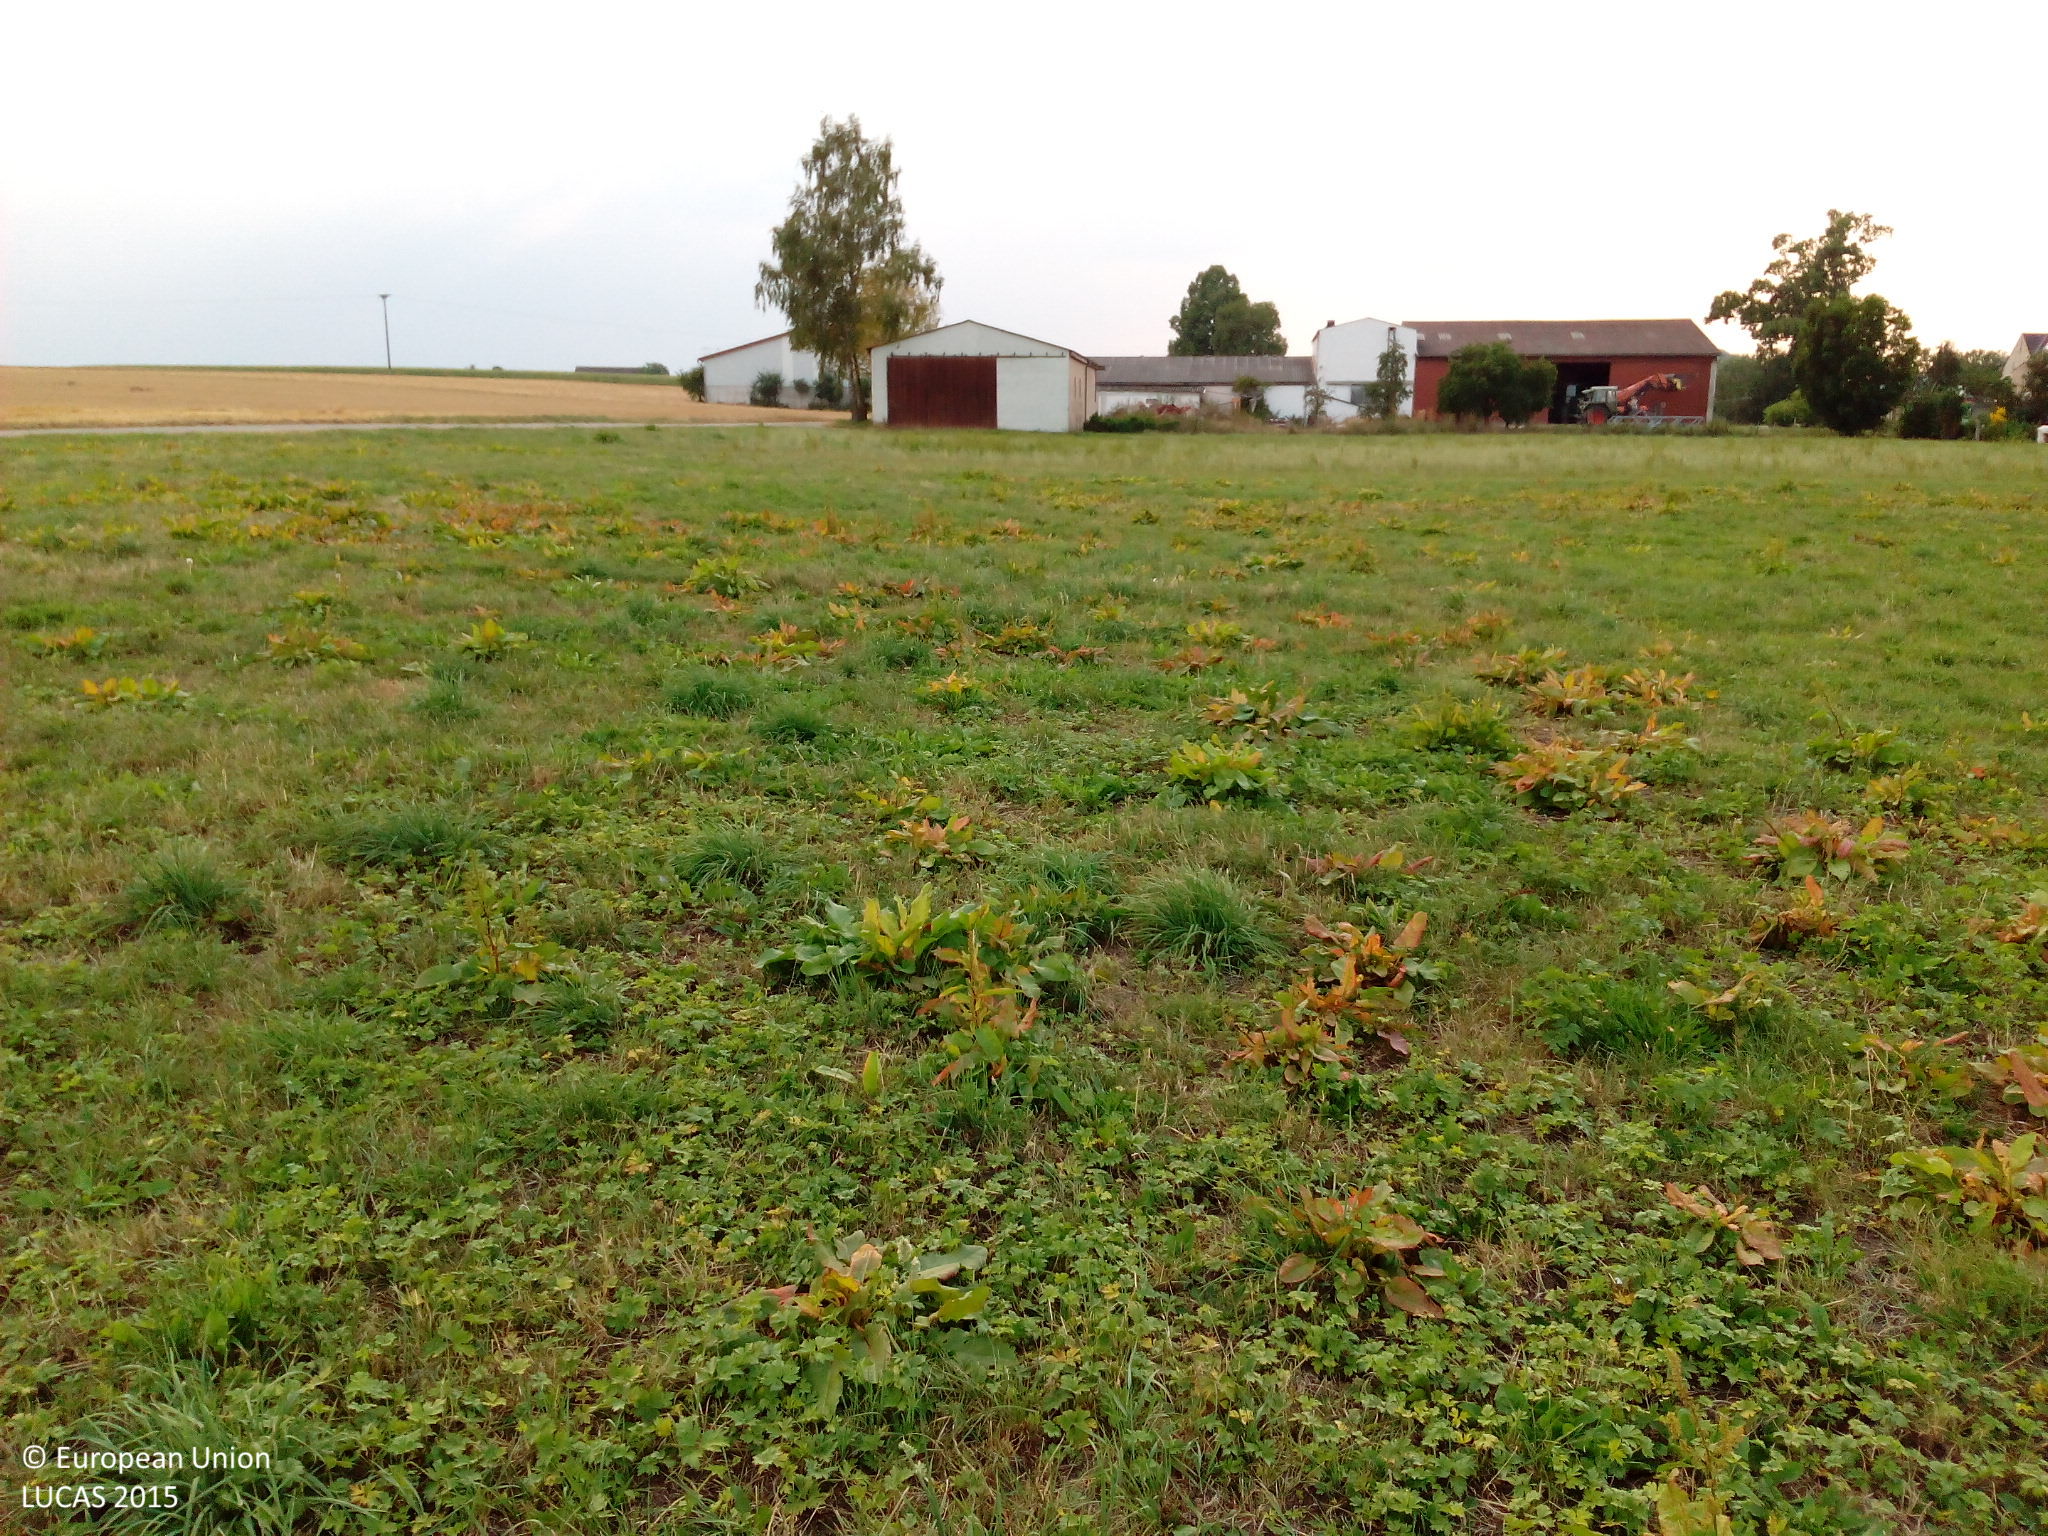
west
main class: Grassland
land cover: Grassland without tree/shrub cover
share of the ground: > 75 %
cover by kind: herbaceous plants 95 %, unconsolidated bare surface 5 %
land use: Agriculture (excluding fallow land and kitchen gardens)
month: August
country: DE
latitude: 48.9599
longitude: 10.5324
